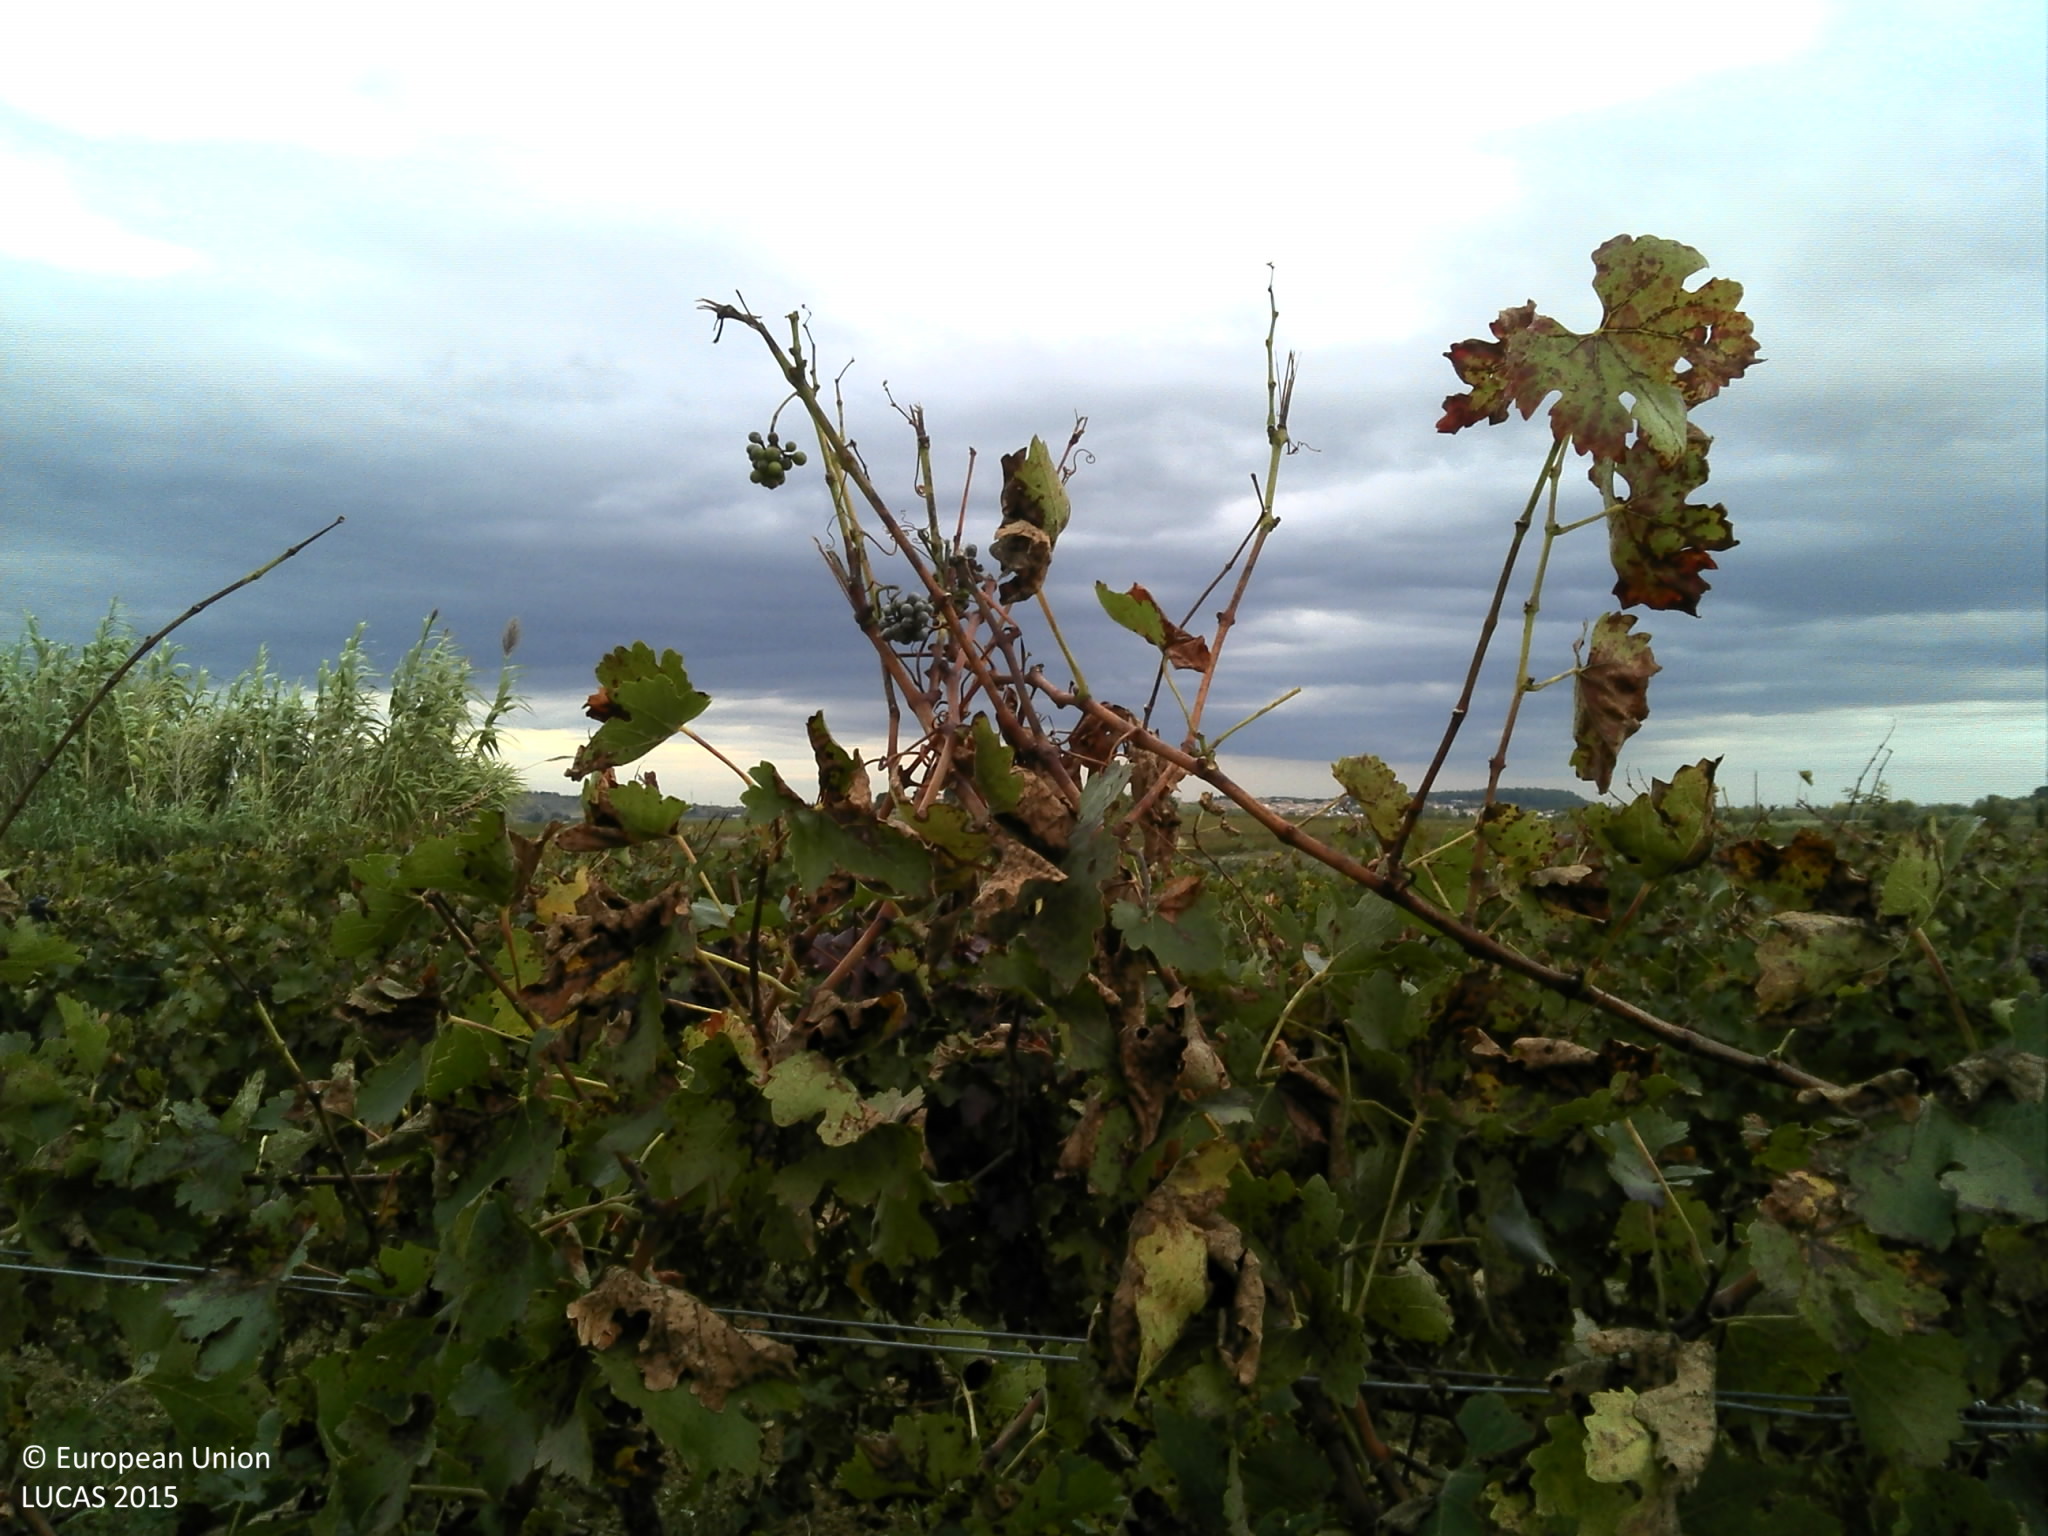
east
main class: Cropland
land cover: Vineyards
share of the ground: 10 - 25 %
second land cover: Other bare soil
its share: > 75 %
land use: Agriculture (excluding fallow land and kitchen gardens)
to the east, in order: Vineyards; Other bare soil; Abandoned hedges; Ditches and canals; Grassland without tree/shrub cover; Vineyards
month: October
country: FR
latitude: 43.3596
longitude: 3.0870
